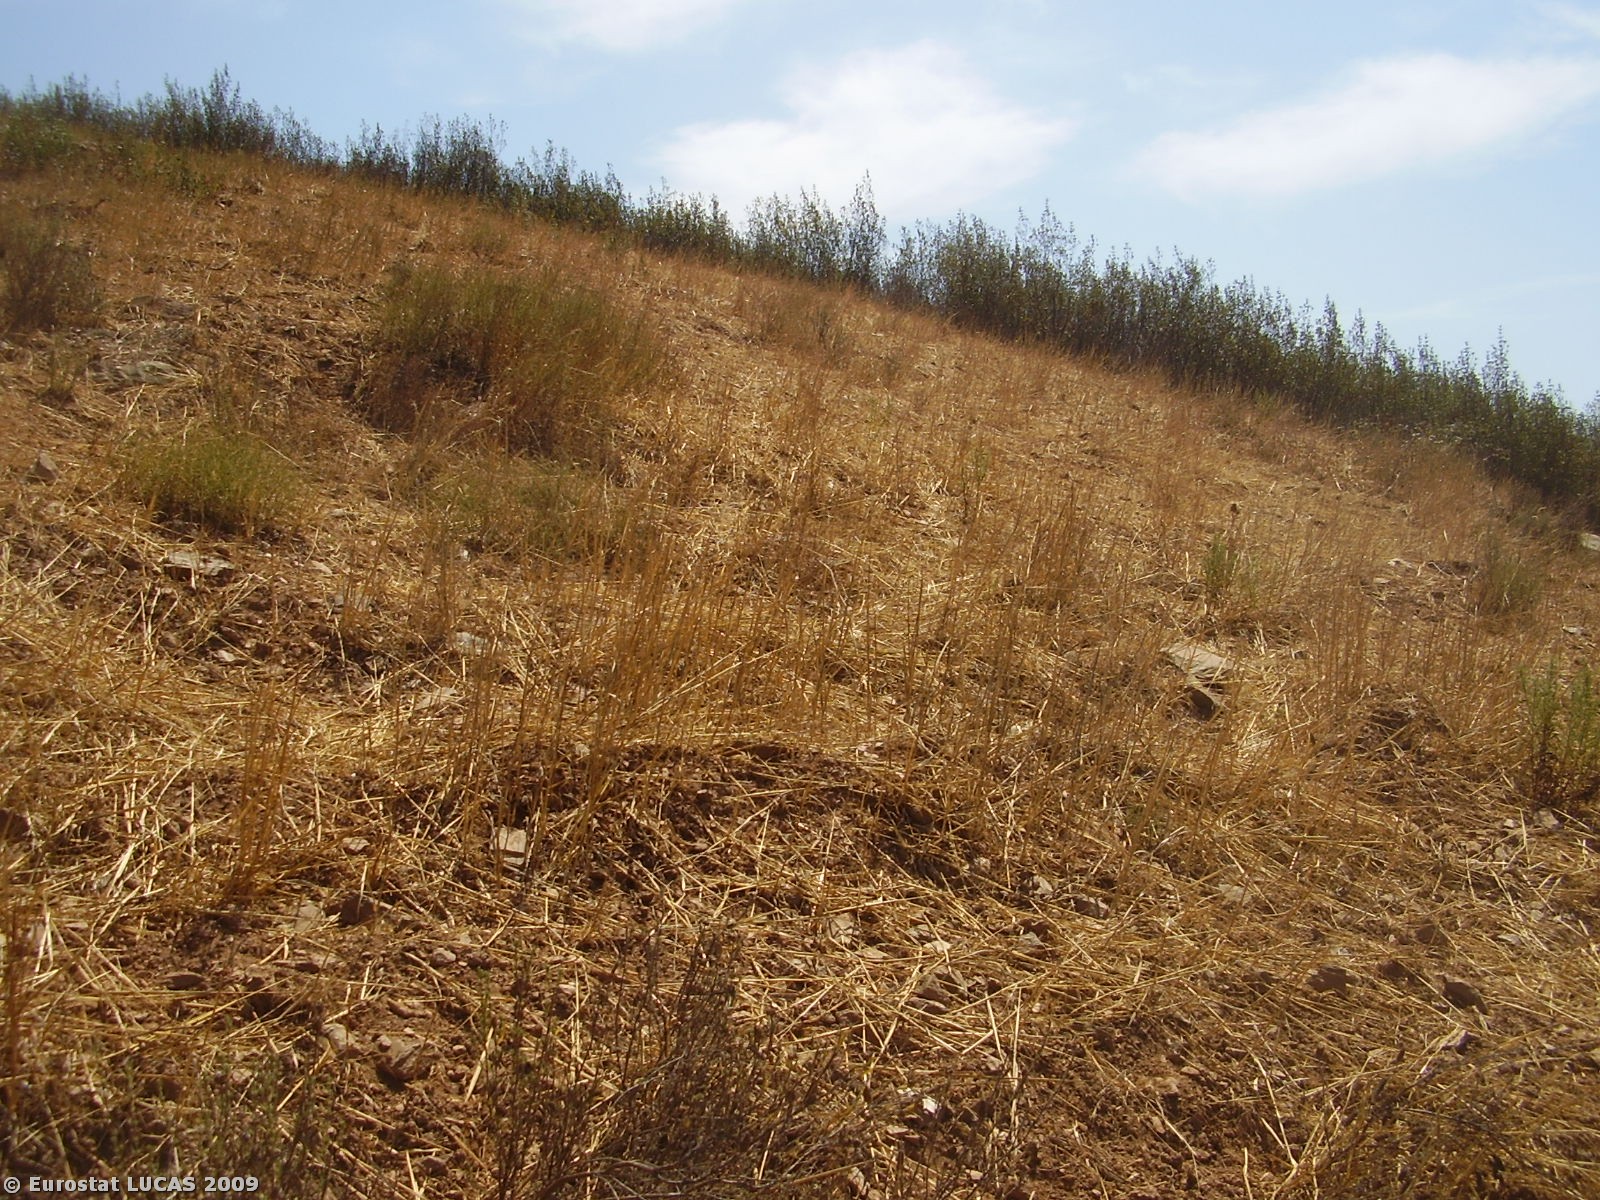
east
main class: Cropland
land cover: Oats
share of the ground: > 75 %
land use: Agriculture (excluding fallow land and kitchen gardens)
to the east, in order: Oats; Shrubland with sparse tree cover
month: August
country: PT
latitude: 37.5953
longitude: -8.3447
